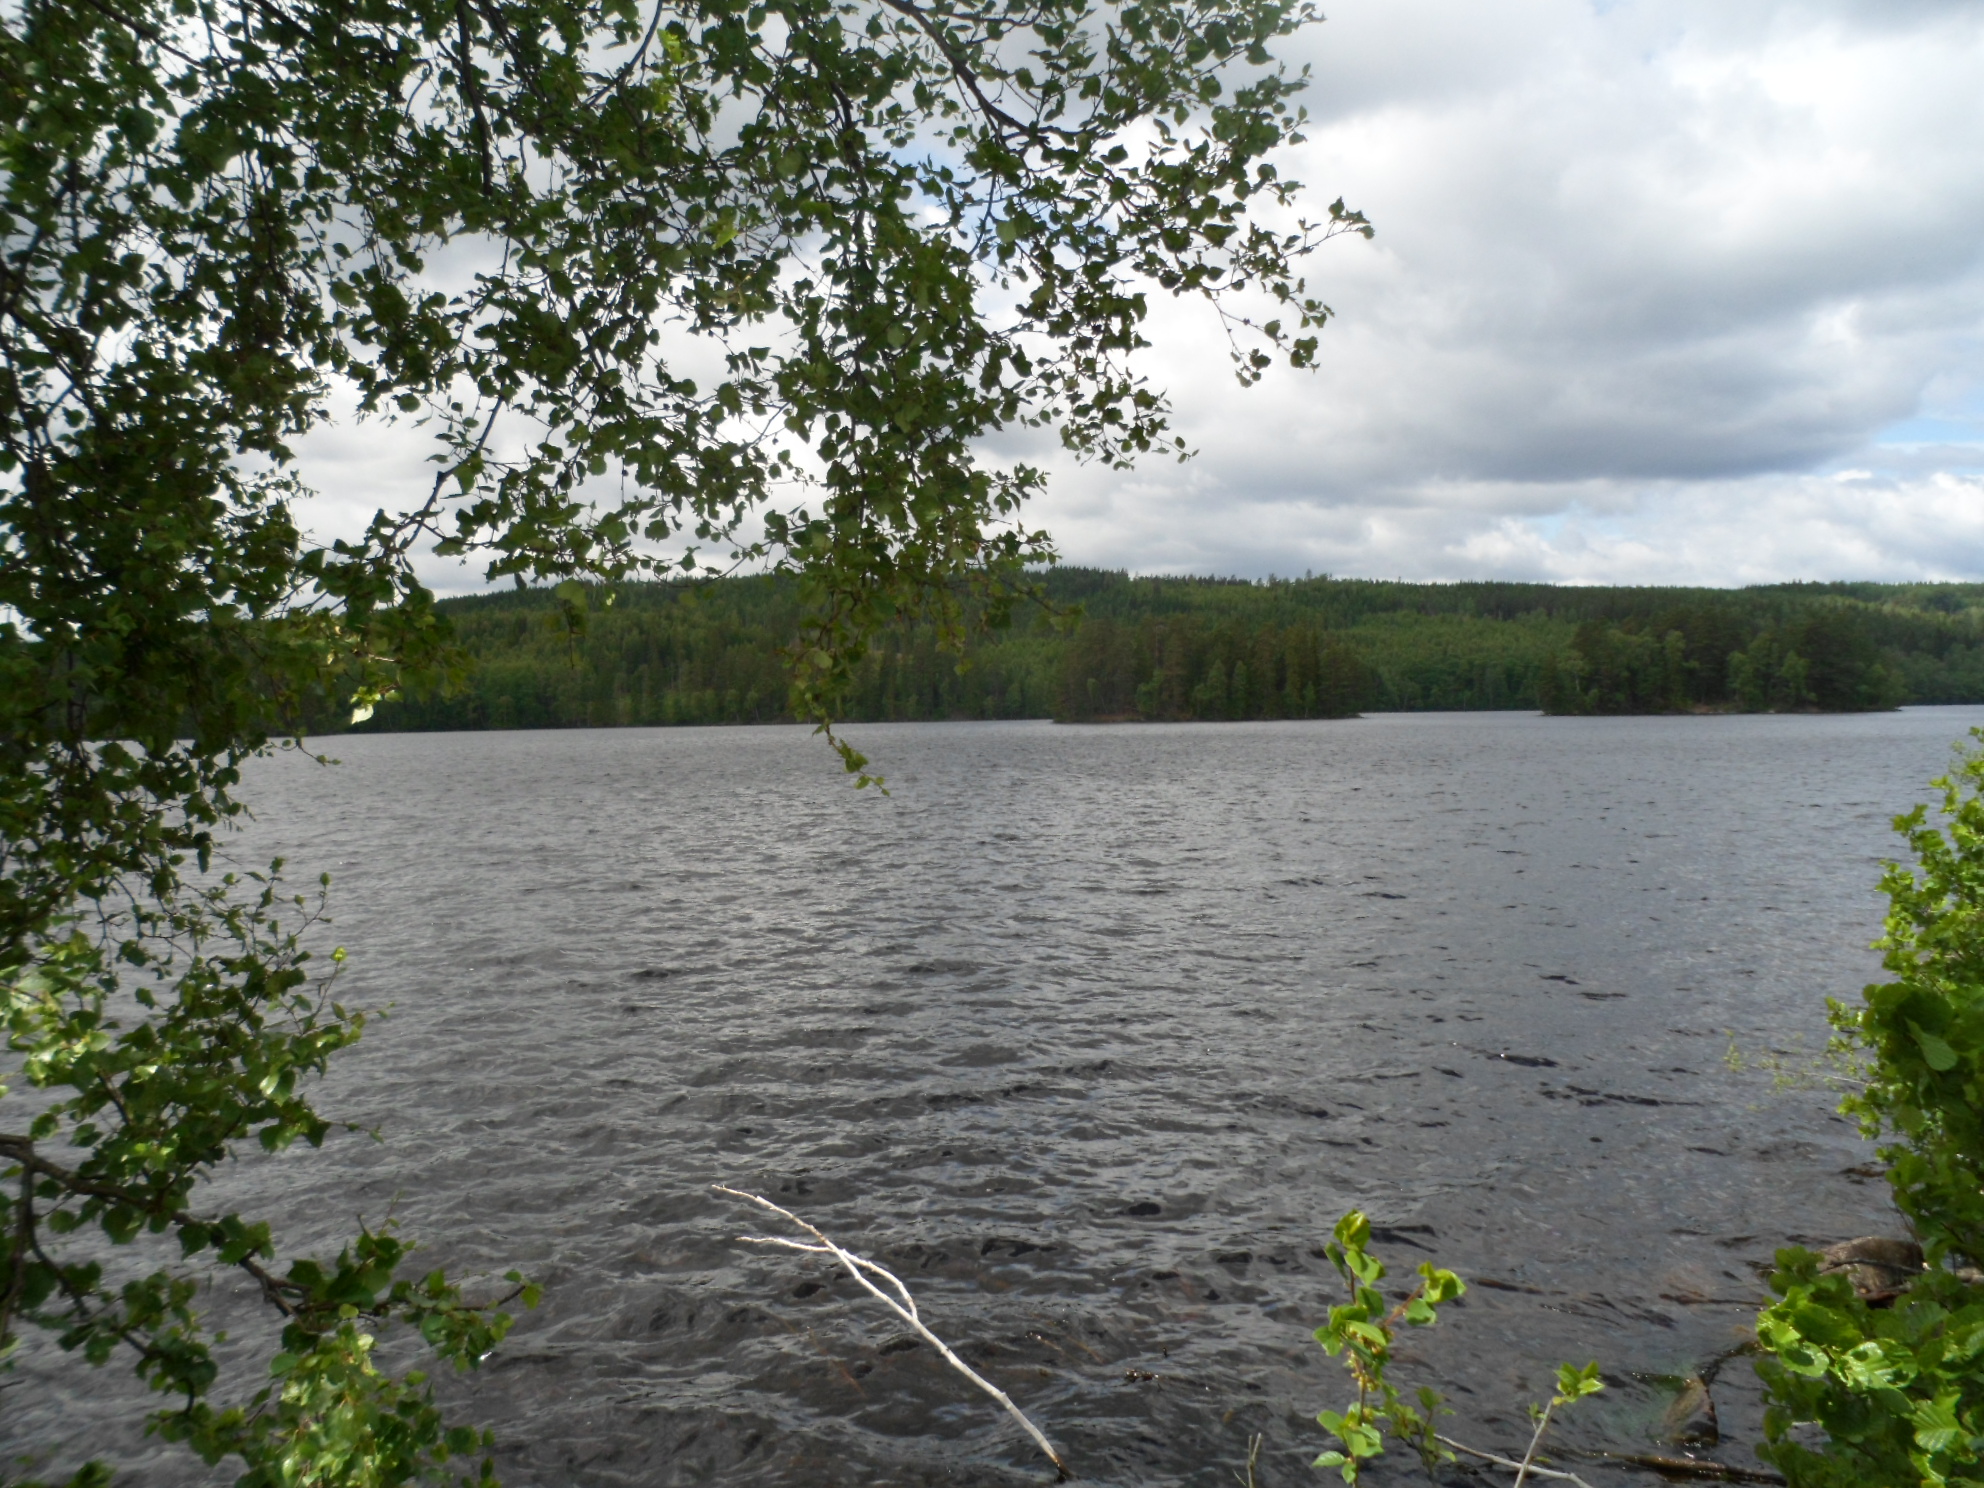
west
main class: Woodland
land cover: Broadleaved woodland
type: hemiboreal forest and nemoral coniferous forest and mixed broadleaved-coniferous forest
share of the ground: 25 - 50 %
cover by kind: shrubs 40 %, herbaceous plants 30 %, broadleaved forest trees 25 %, lichens and mosses 5 %
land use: Forestry
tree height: > 5 m
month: June
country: SE
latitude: 57.1247
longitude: 14.8034
